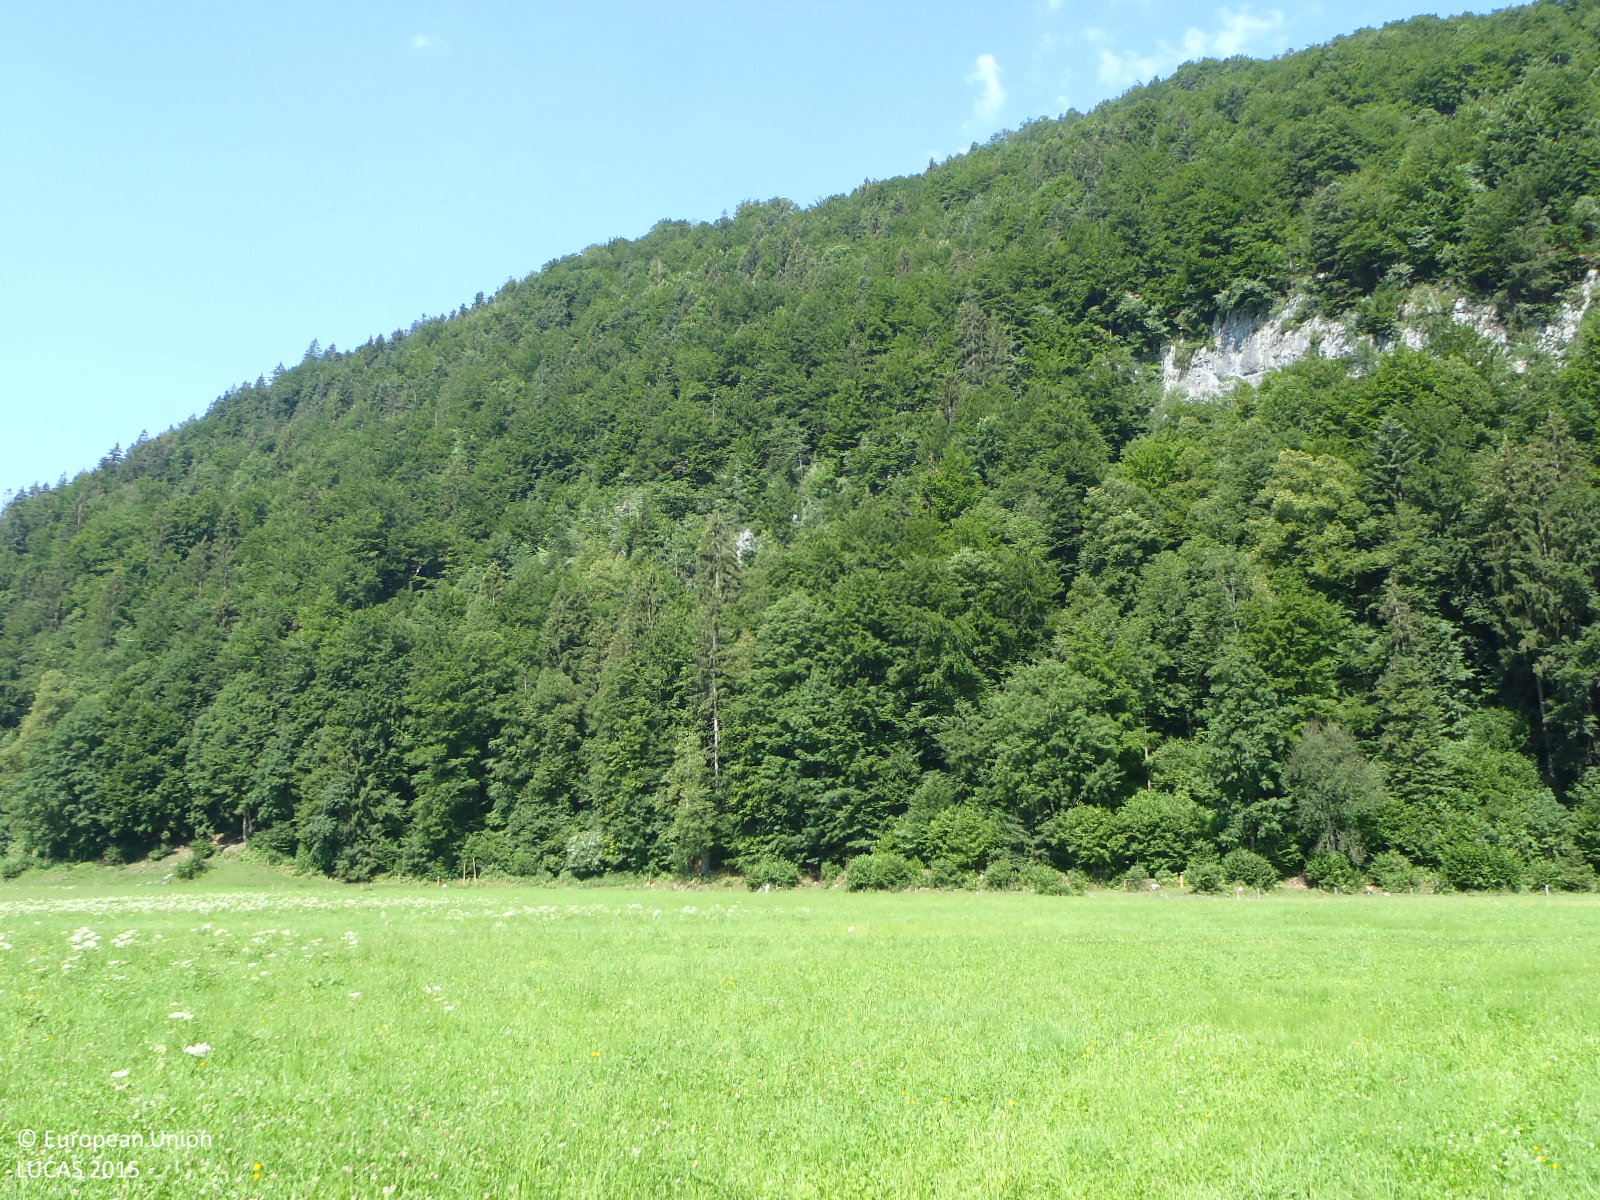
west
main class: Grassland
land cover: Grassland without tree/shrub cover
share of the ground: > 75 %
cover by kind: herbaceous plants 100 %
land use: Agriculture (excluding fallow land and kitchen gardens)
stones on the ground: < 10 %
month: July
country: AT
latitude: 47.5660
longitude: 12.4574
